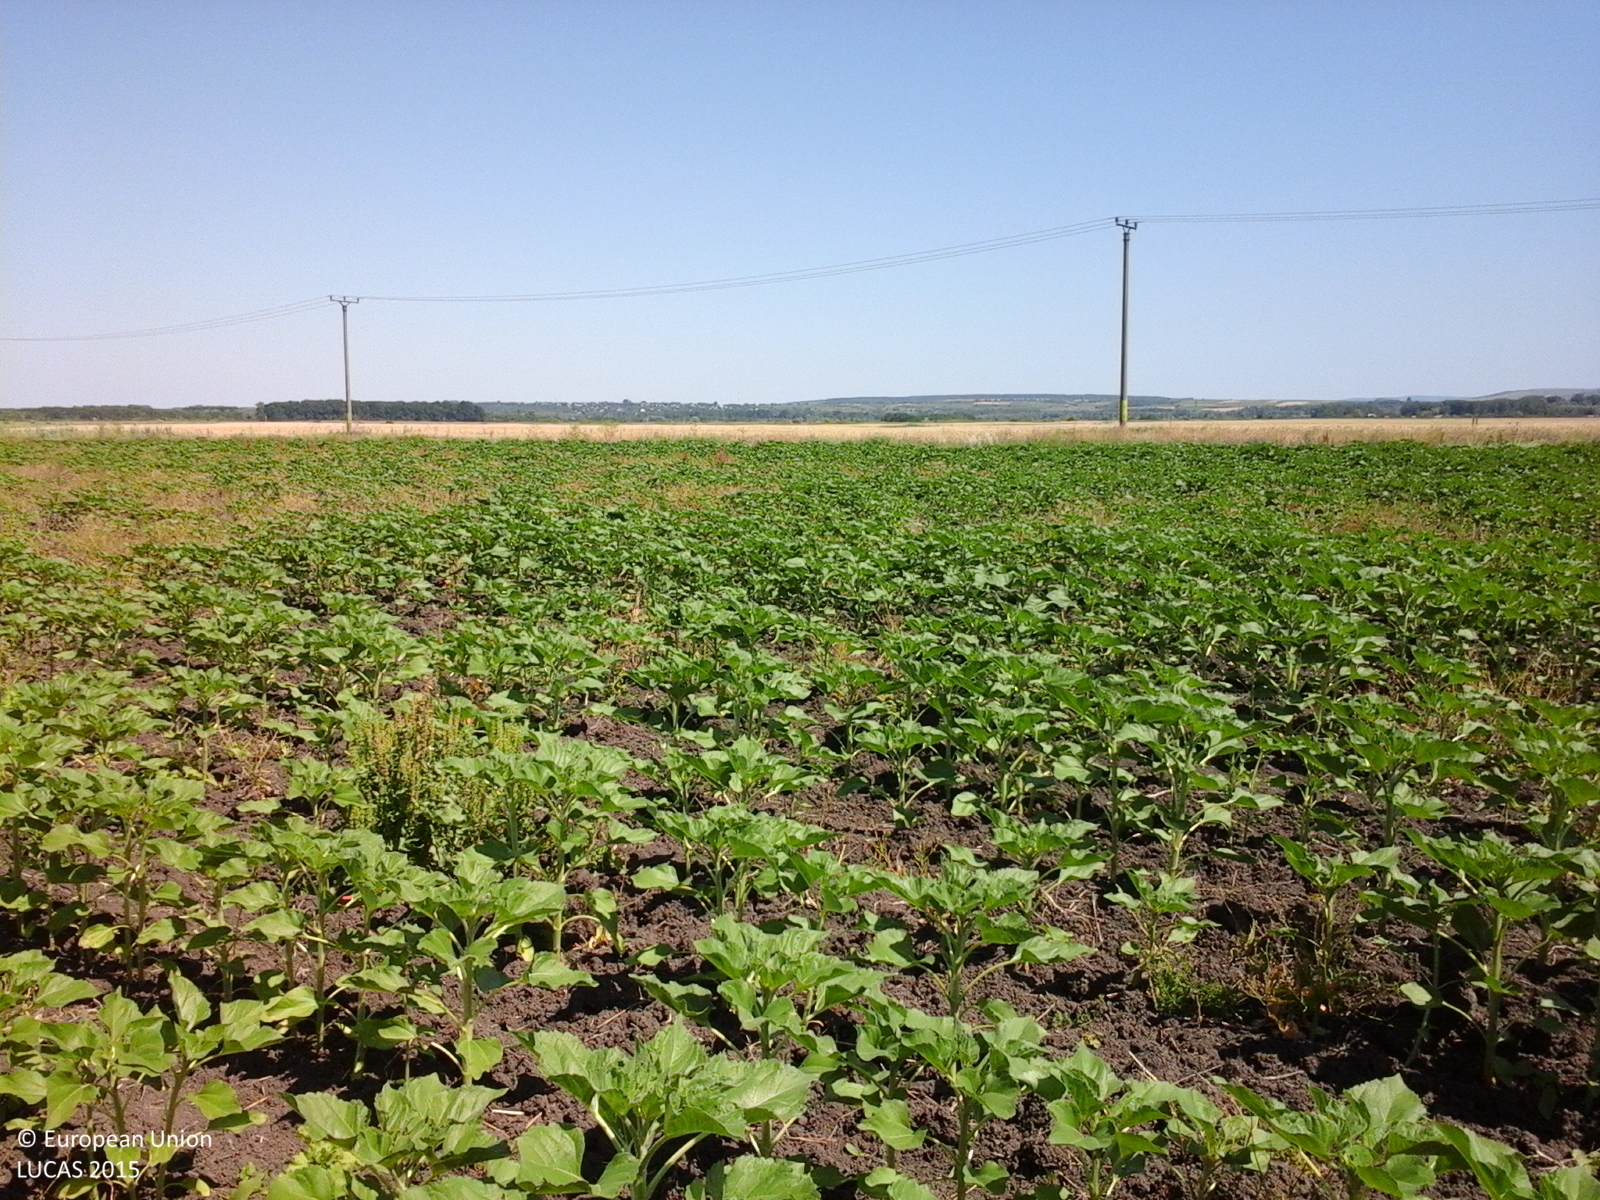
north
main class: Cropland
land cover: Sunflower
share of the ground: > 75 %
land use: Agriculture (excluding fallow land and kitchen gardens)
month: June
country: RO
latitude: 47.0316
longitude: 27.9325
